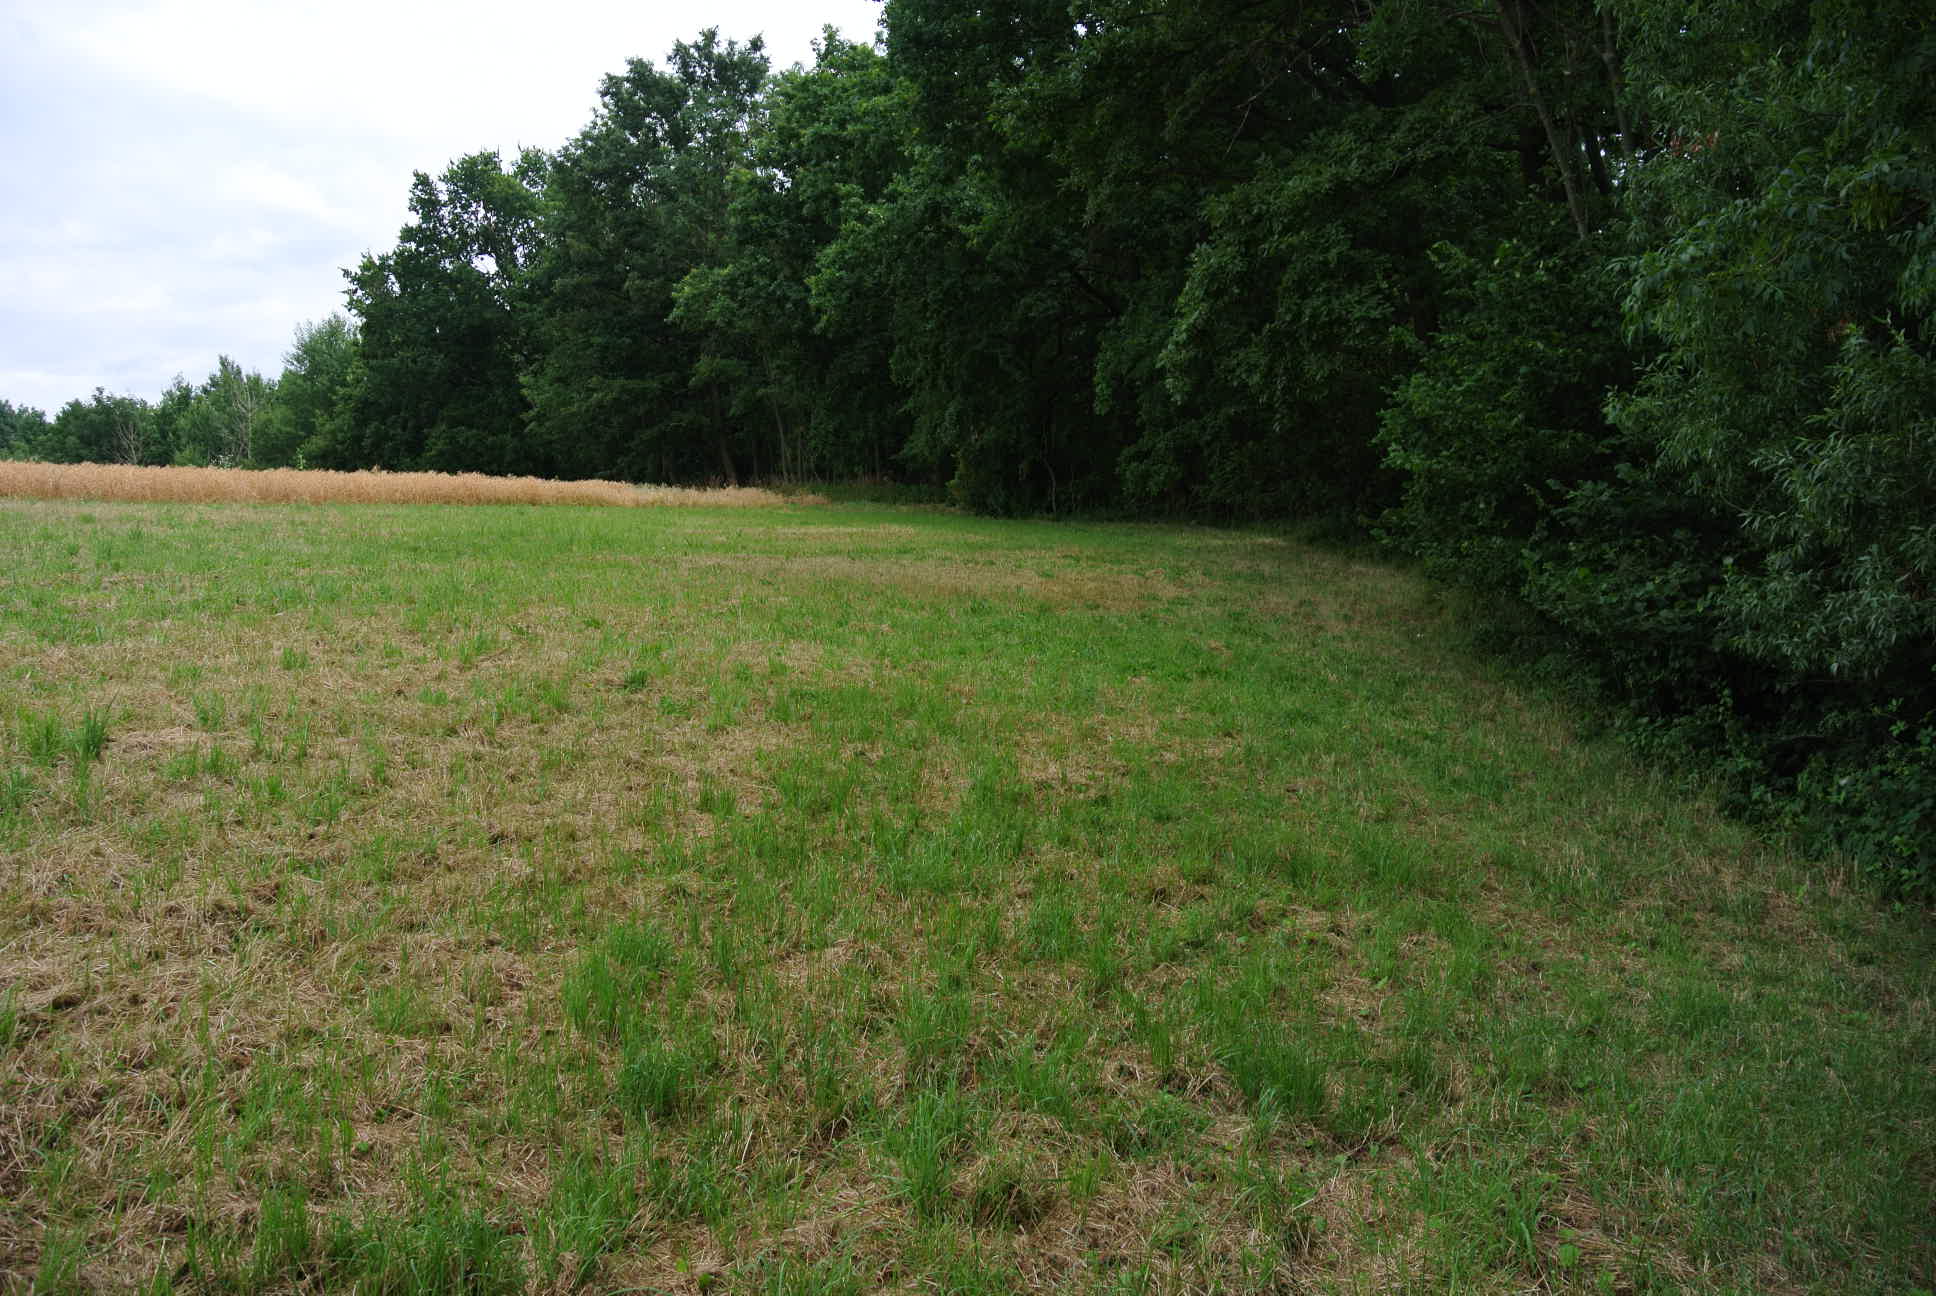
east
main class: Grassland
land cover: Grassland without tree/shrub cover
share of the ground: > 75 %
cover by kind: herbaceous plants 100 %
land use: Agriculture (excluding fallow land and kitchen gardens)
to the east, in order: Grassland without tree/shrub cover; Soya; Broadleaved woodland; Rivers and streams; Broadleaved woodland; Grassland without tree/shrub cover
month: July
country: AT
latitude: 47.5684
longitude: 16.3973
